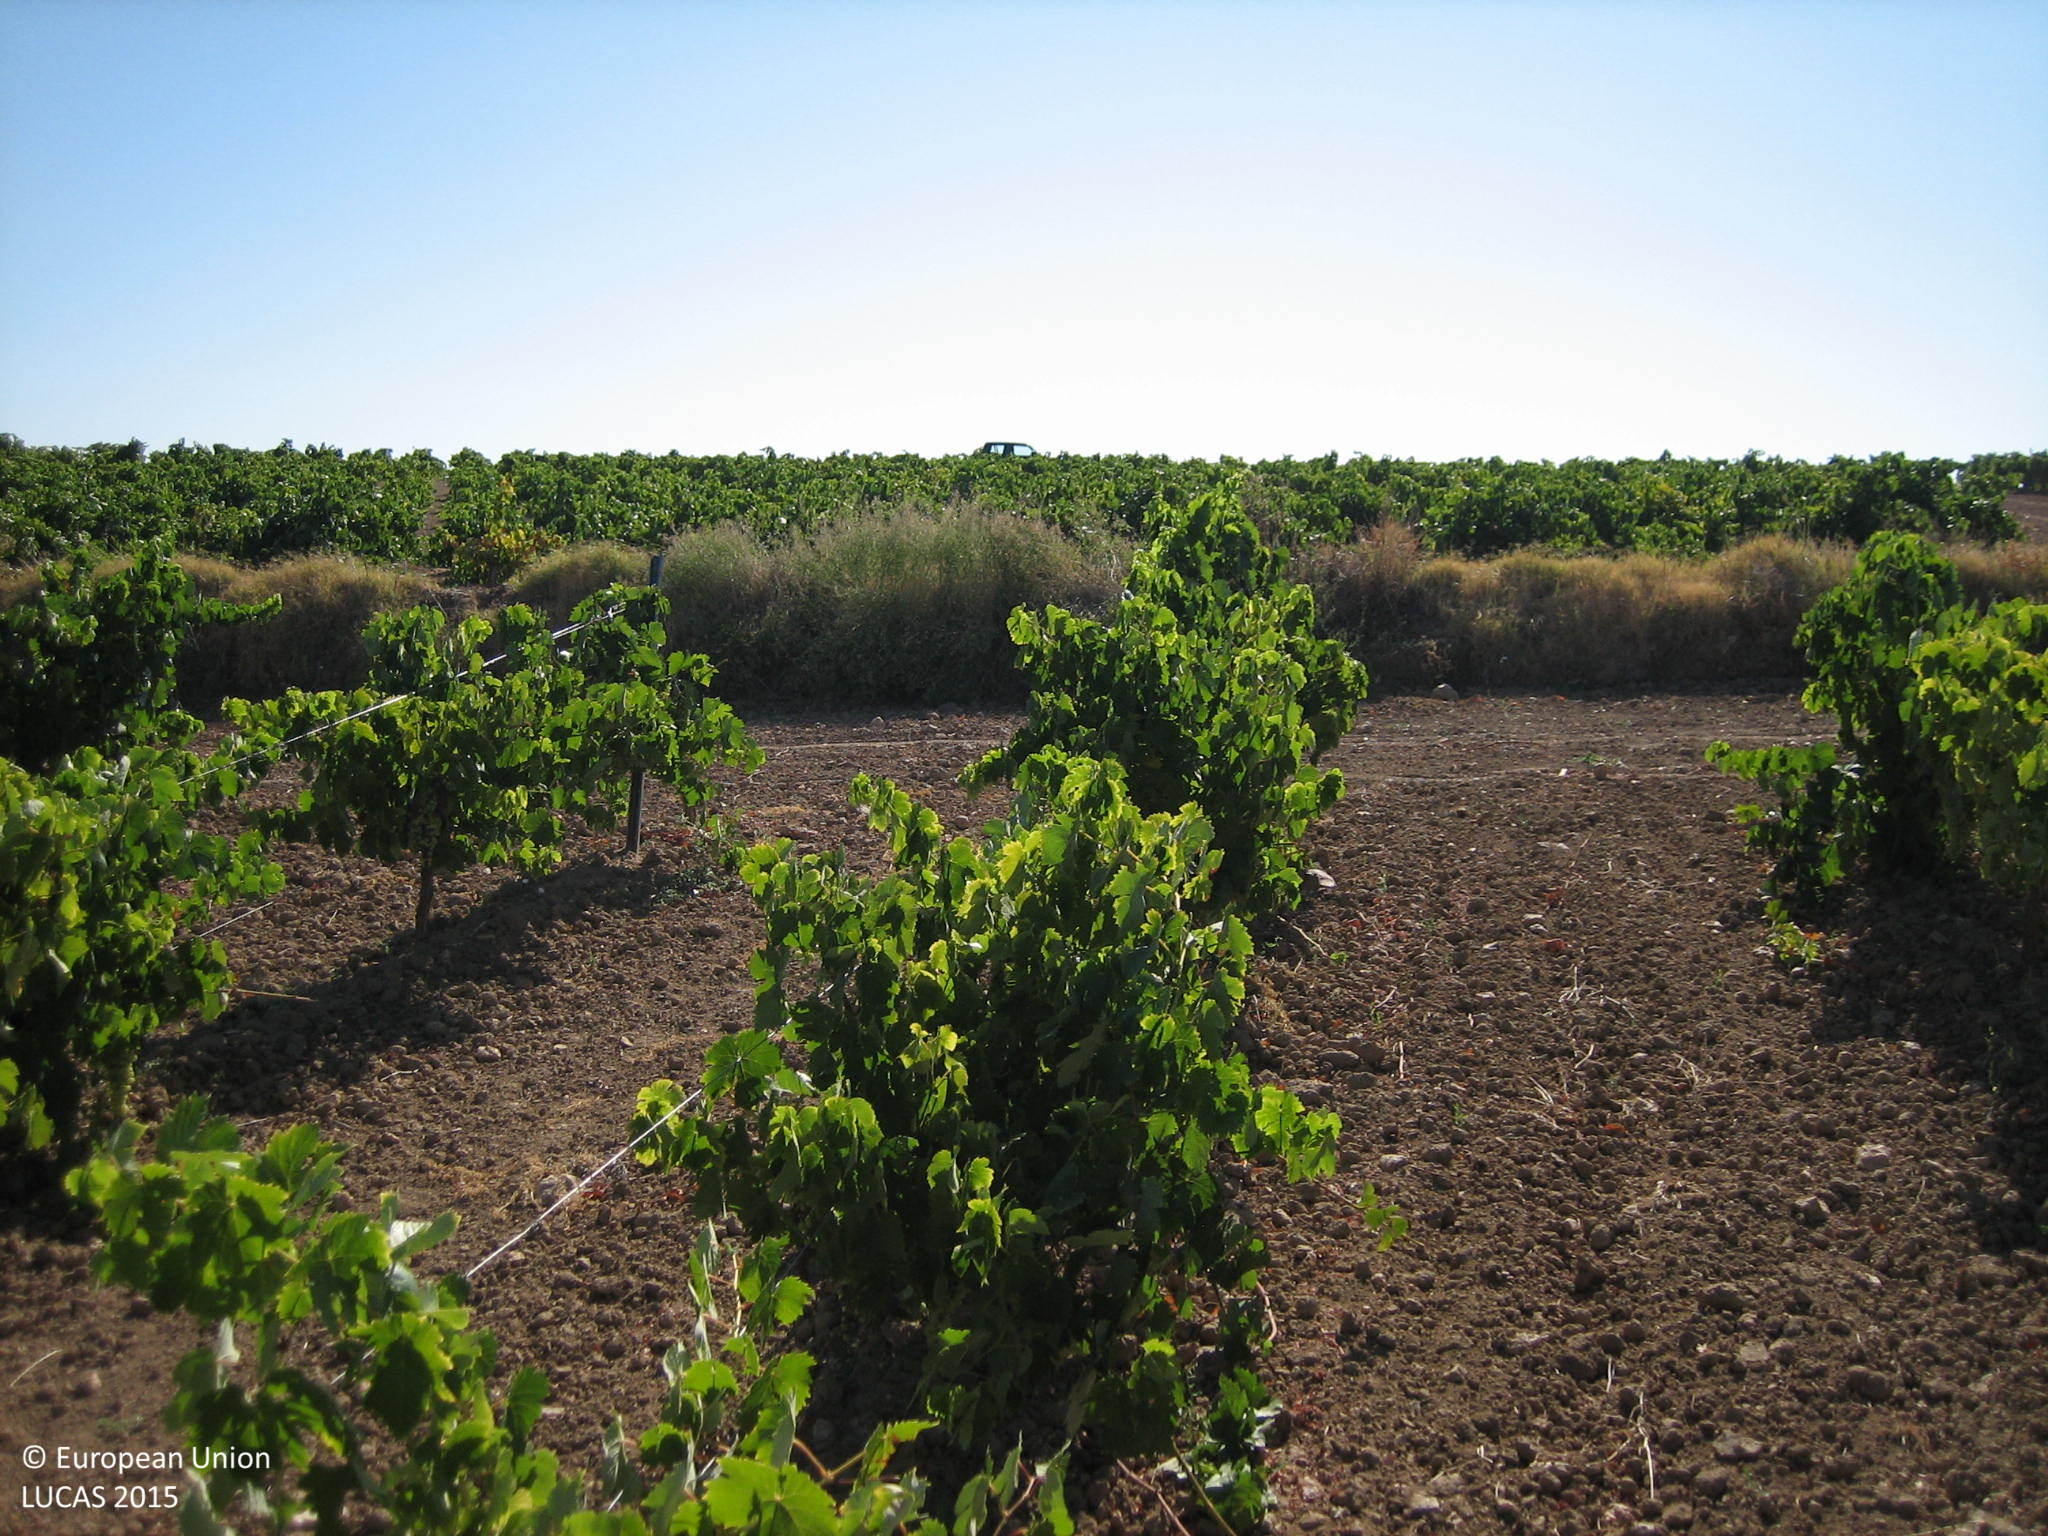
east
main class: Cropland
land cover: Vineyards
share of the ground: 25 - 50 %
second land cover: Other bare soil
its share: > 75 %
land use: Agriculture (excluding fallow land and kitchen gardens)
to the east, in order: Vineyards; Other bare soil; Grass margins; Vineyards; Tracks; Vineyards
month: July
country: ES
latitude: 38.4817
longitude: -6.3395
